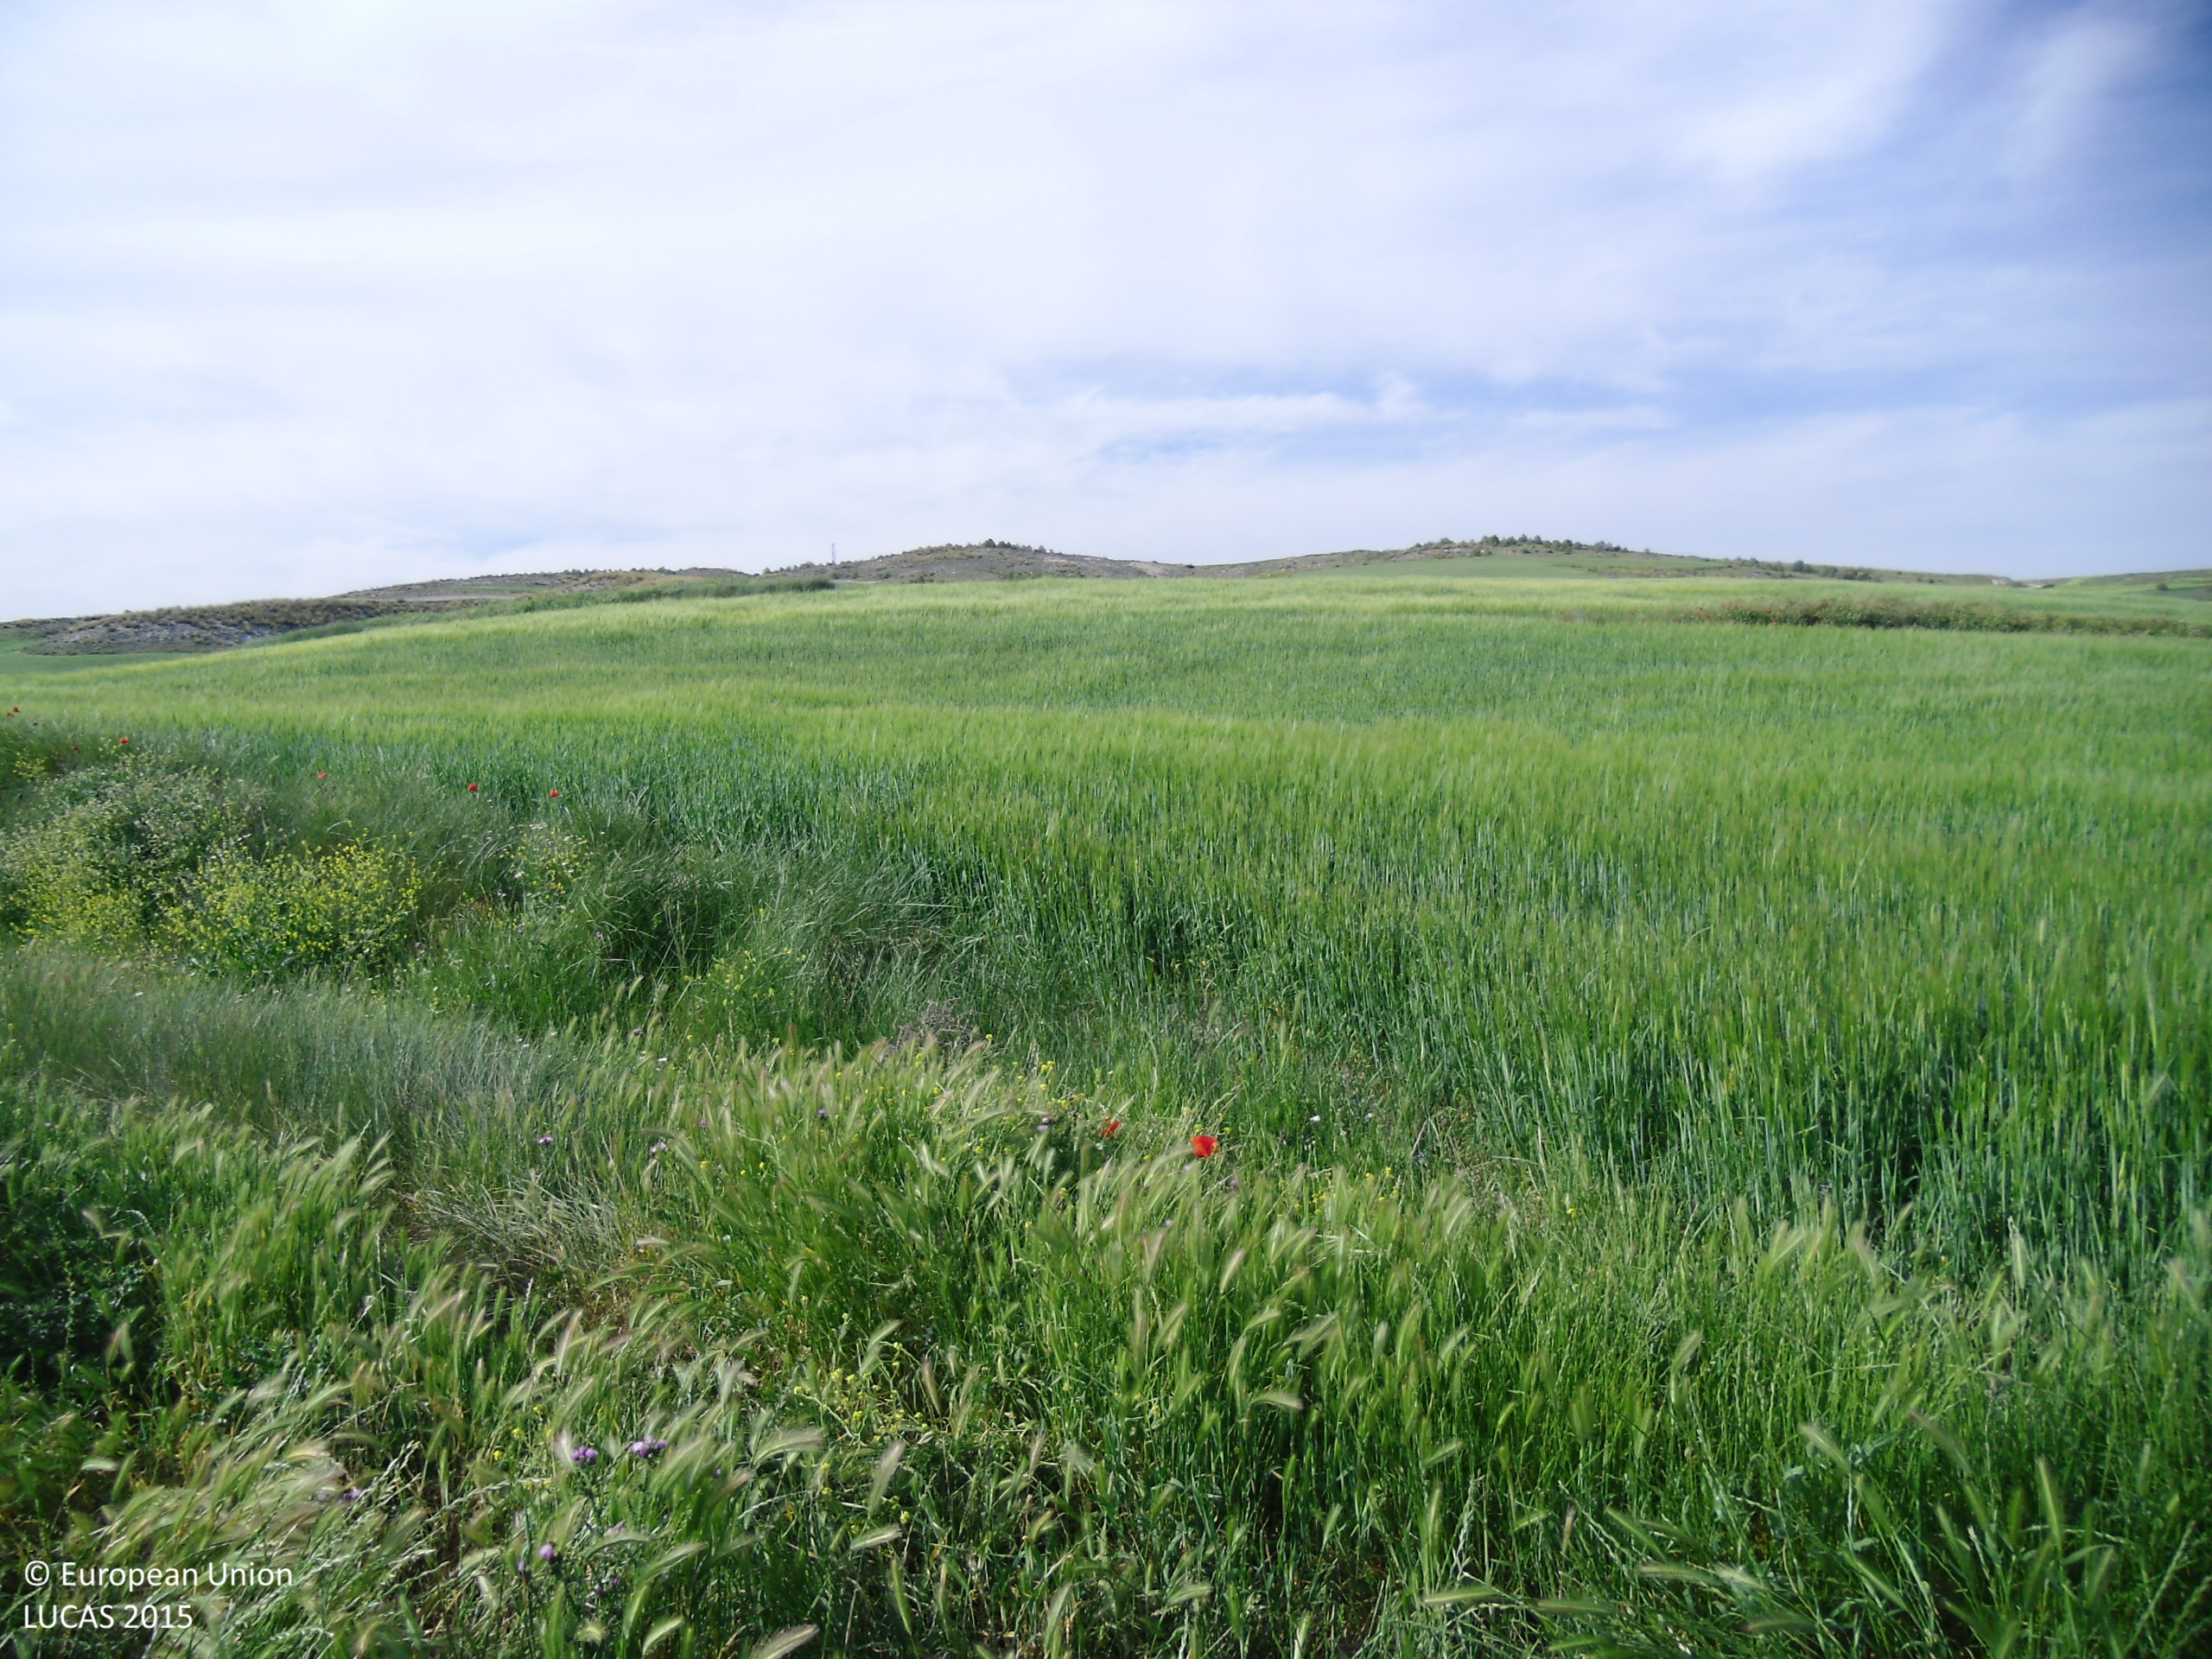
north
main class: Cropland
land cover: Barley
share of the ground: > 75 %
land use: Agriculture (excluding fallow land and kitchen gardens)
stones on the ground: < 10 %
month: May
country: ES
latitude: 40.3363
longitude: -2.9640
